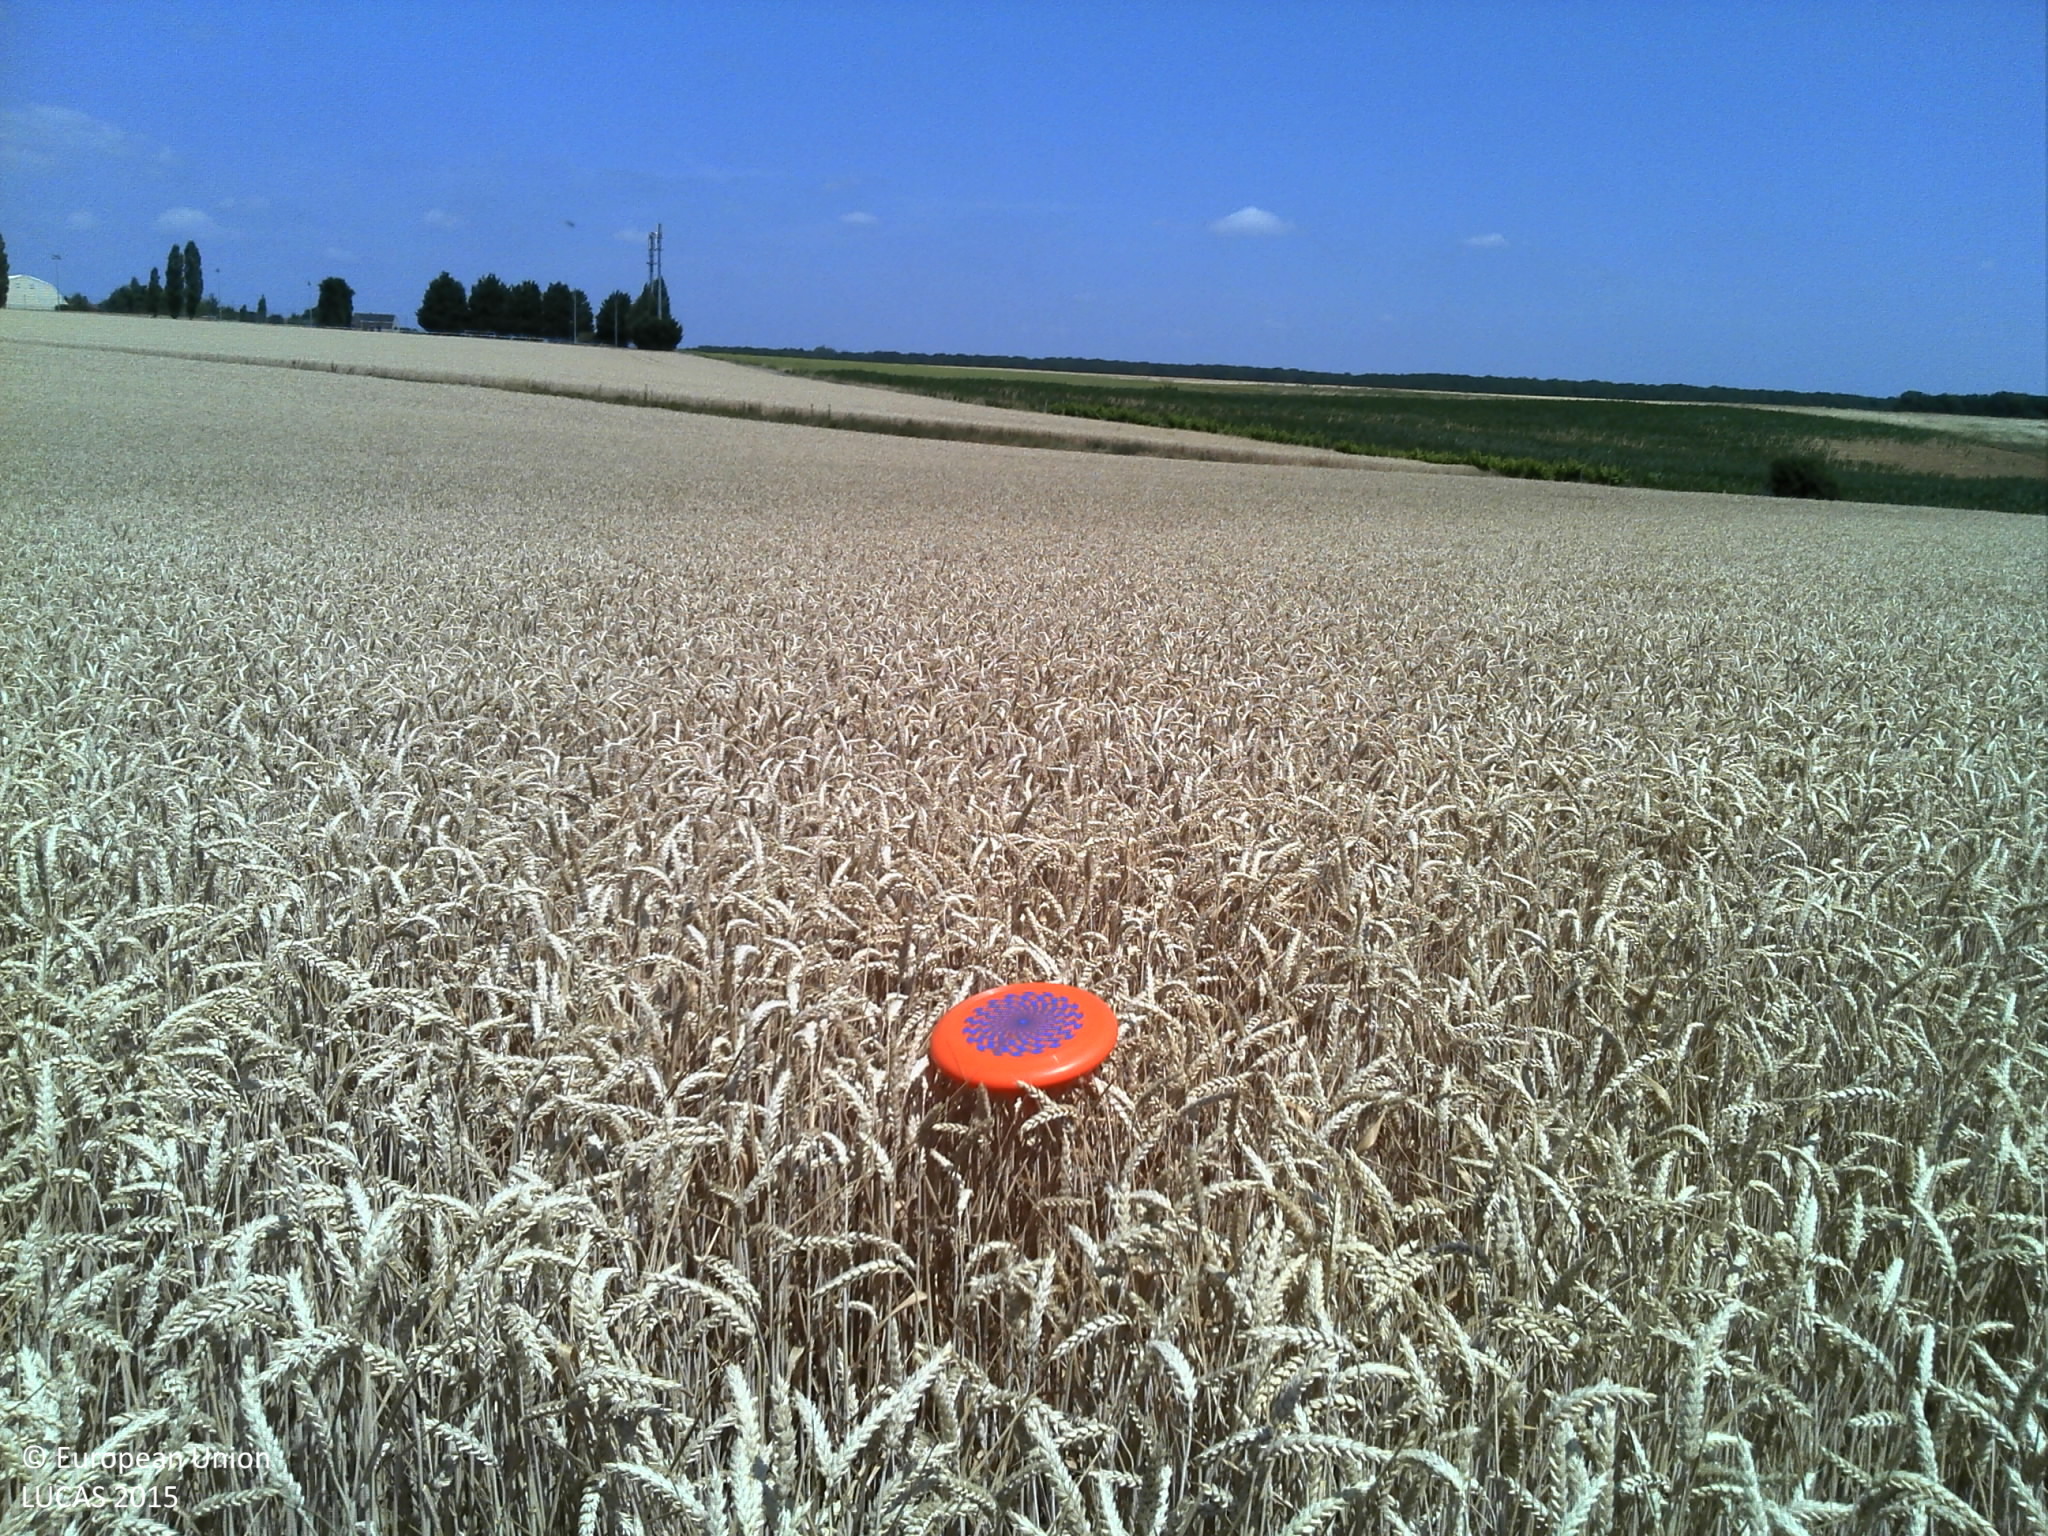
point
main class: Cropland
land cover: Common wheat
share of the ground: > 75 %
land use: Agriculture (excluding fallow land and kitchen gardens)
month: July
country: FR
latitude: 48.4903
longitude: 1.9623
